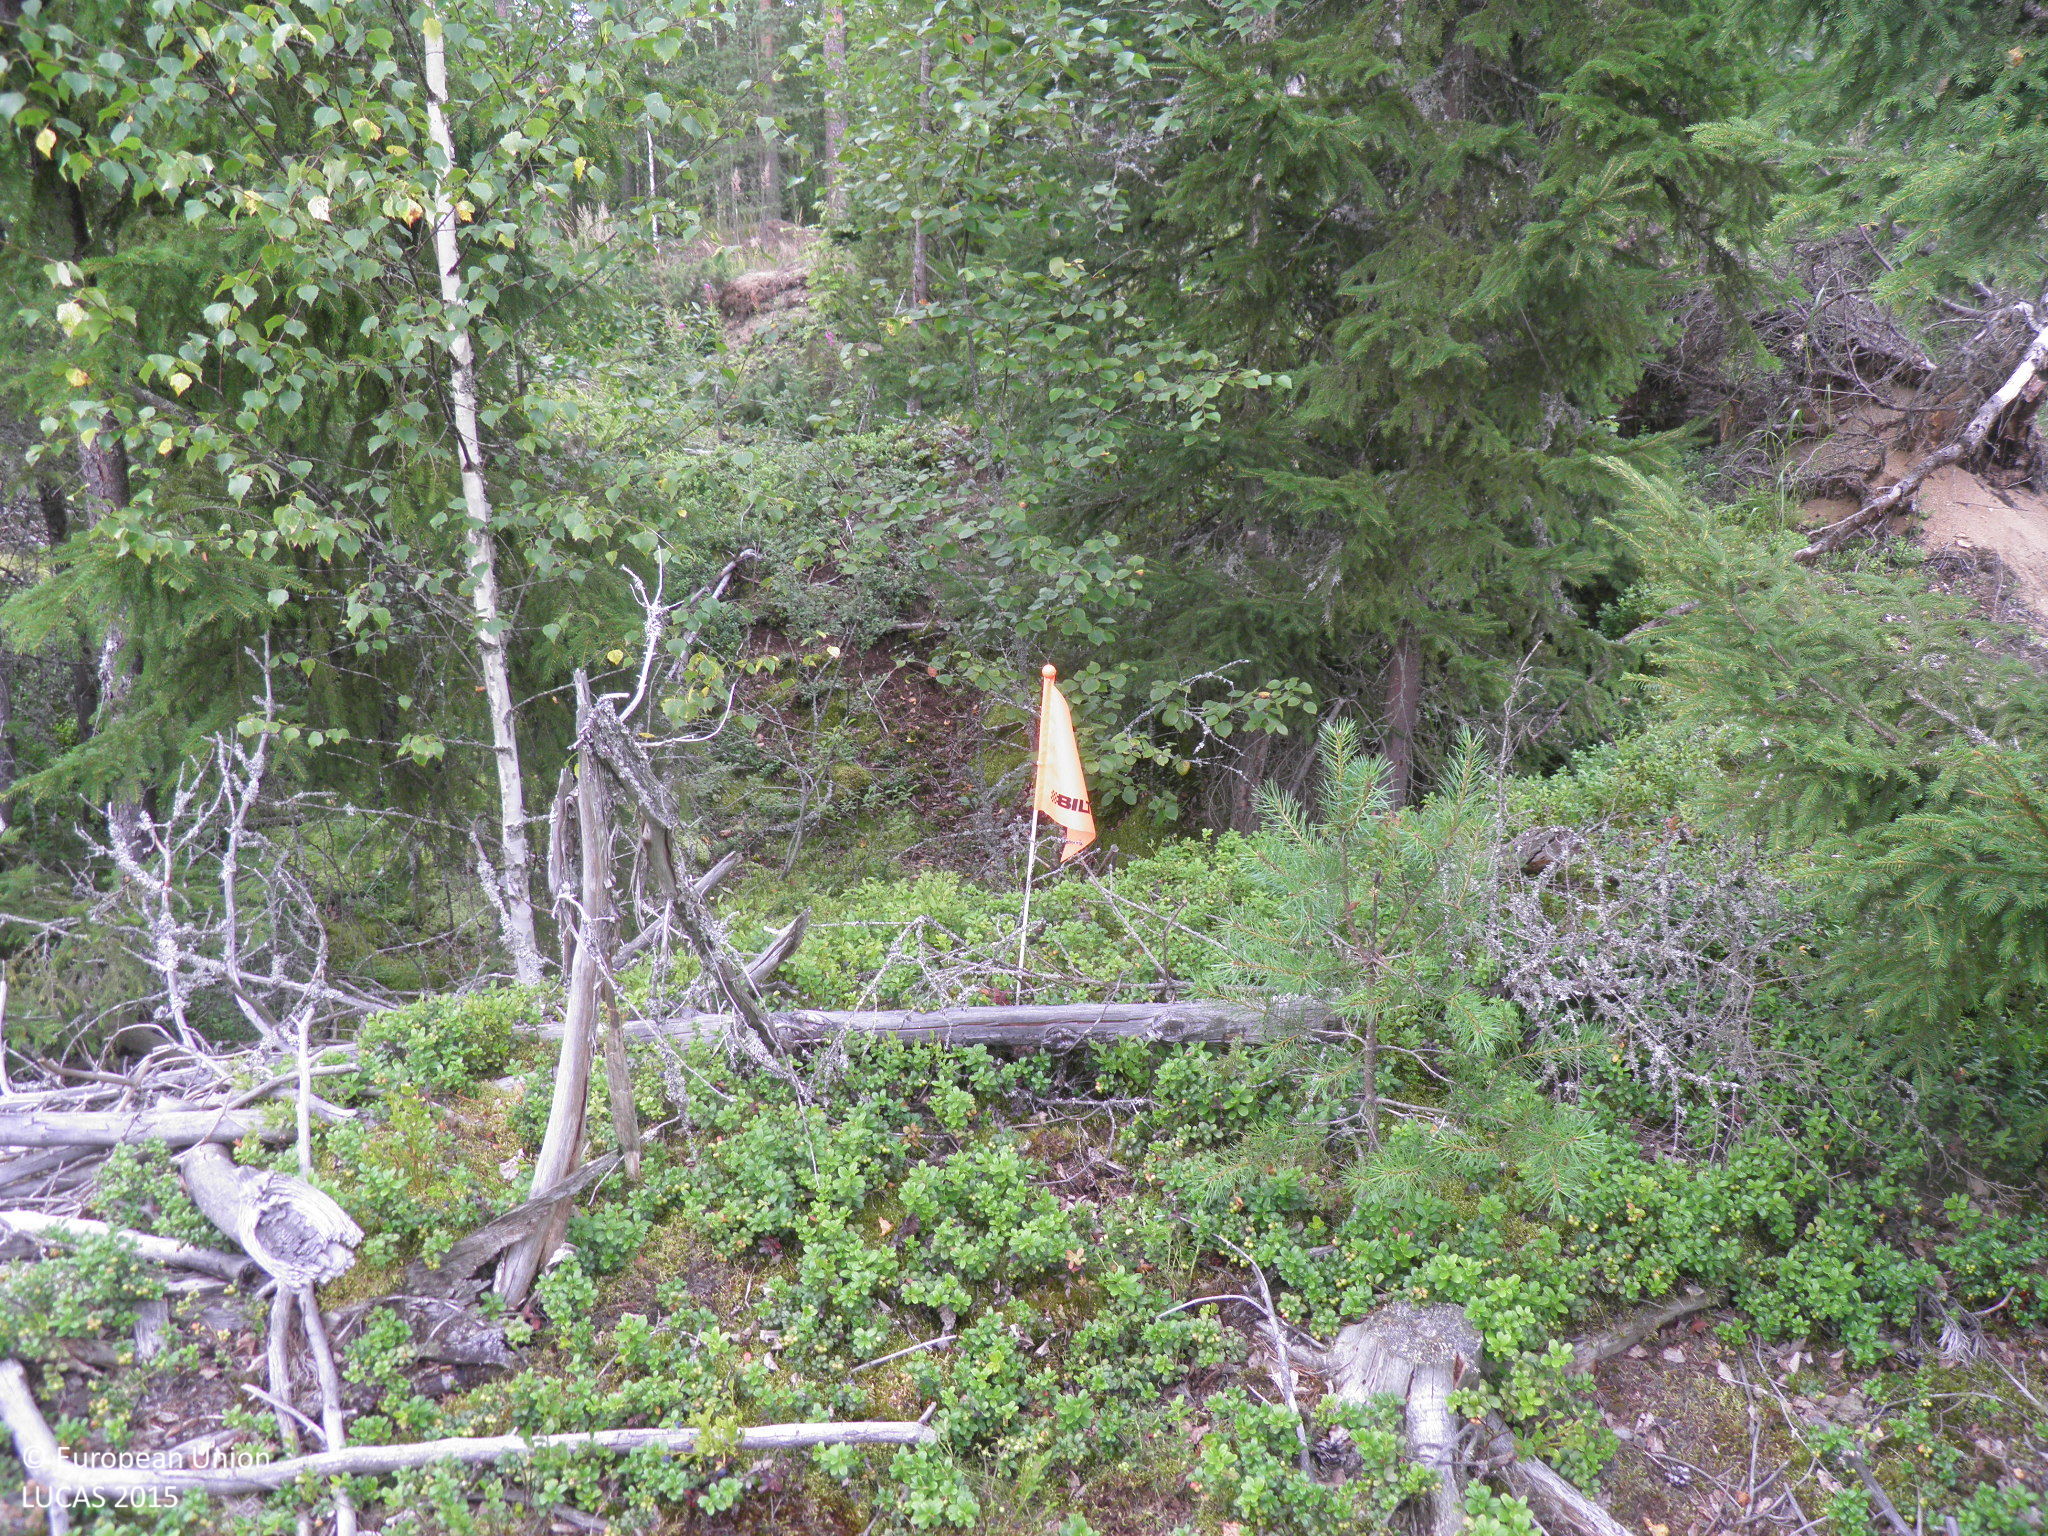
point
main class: Woodland
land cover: Other mixed woodland
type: hemiboreal forest and nemoral coniferous forest and mixed broadleaved-coniferous forest
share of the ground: 25 - 50 %
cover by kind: coniferous forest trees 20 %, broadleaved forest trees 20 %, shrubs 20 %, herbaceous plants 20 %, lichens and mosses 20 %
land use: Forestry
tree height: > 5 m
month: August
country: FI
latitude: 61.1036
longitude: 22.8911
